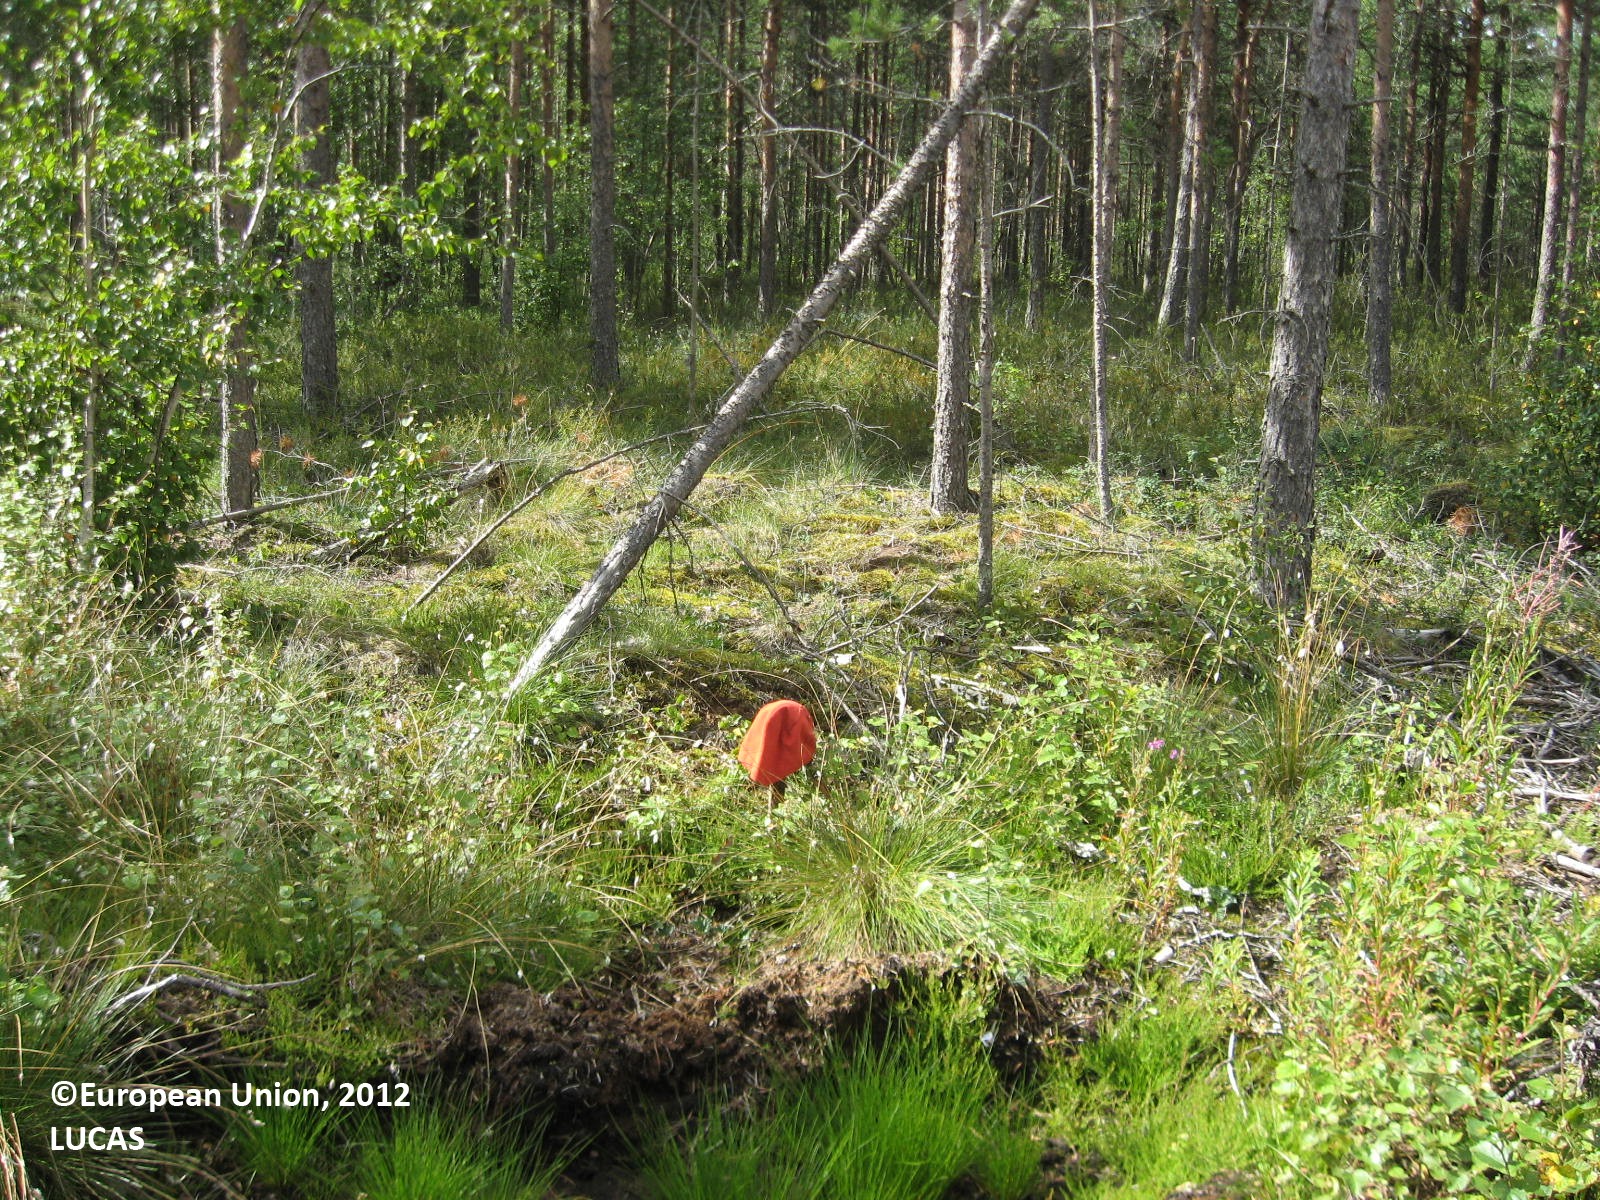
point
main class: Woodland
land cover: Pine dominated coniferous woodland
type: boreal forest
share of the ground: > 75 %
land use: Forestry
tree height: > 5 m
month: July
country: FI
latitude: 61.9903
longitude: 22.3695
